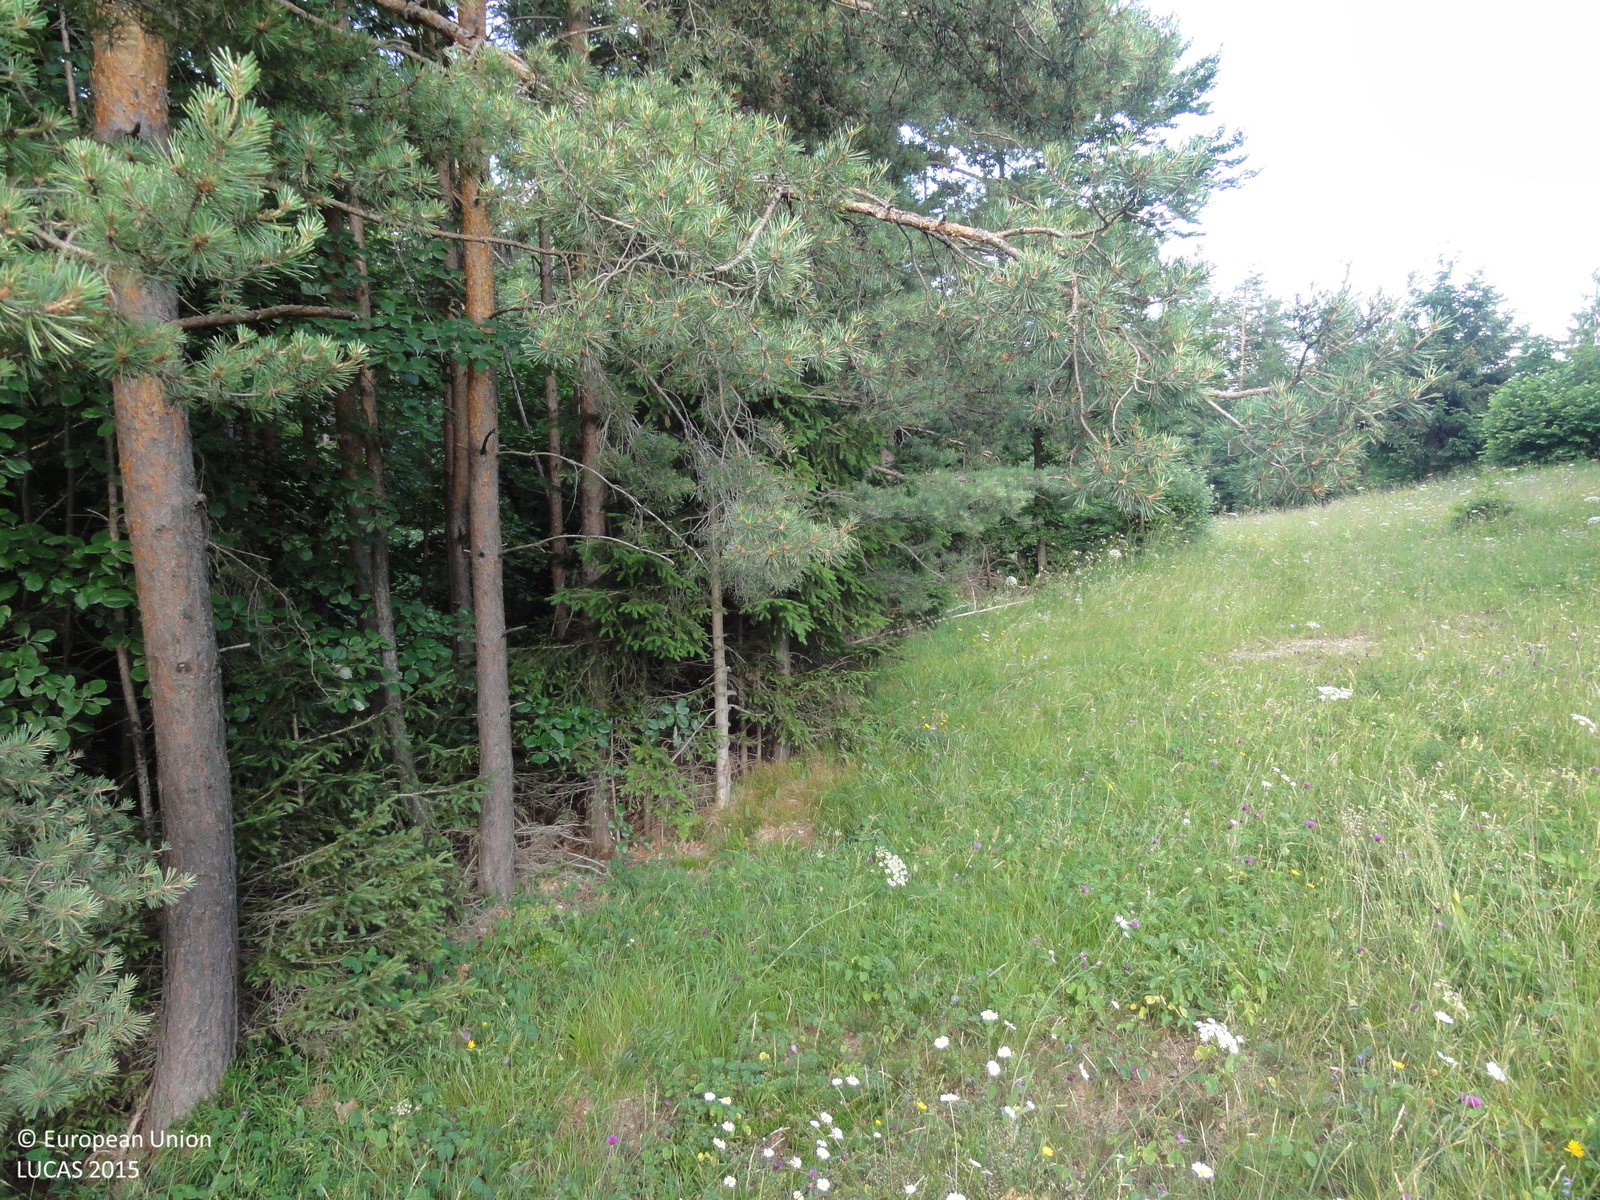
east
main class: Grassland
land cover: Grassland without tree/shrub cover
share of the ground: > 75 %
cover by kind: herbaceous plants 100 %
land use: Agriculture (excluding fallow land and kitchen gardens)
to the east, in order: Grassland without tree/shrub cover; Other mixed woodland; Spruce dominated mixed woodland; Broadleaved woodland; Spruce dominated mixed woodland; Fences; Grassland without tree/shrub cover; Electric lines; Grassland without tree/shrub cover
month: June
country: SI
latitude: 46.3661
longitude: 15.2623
